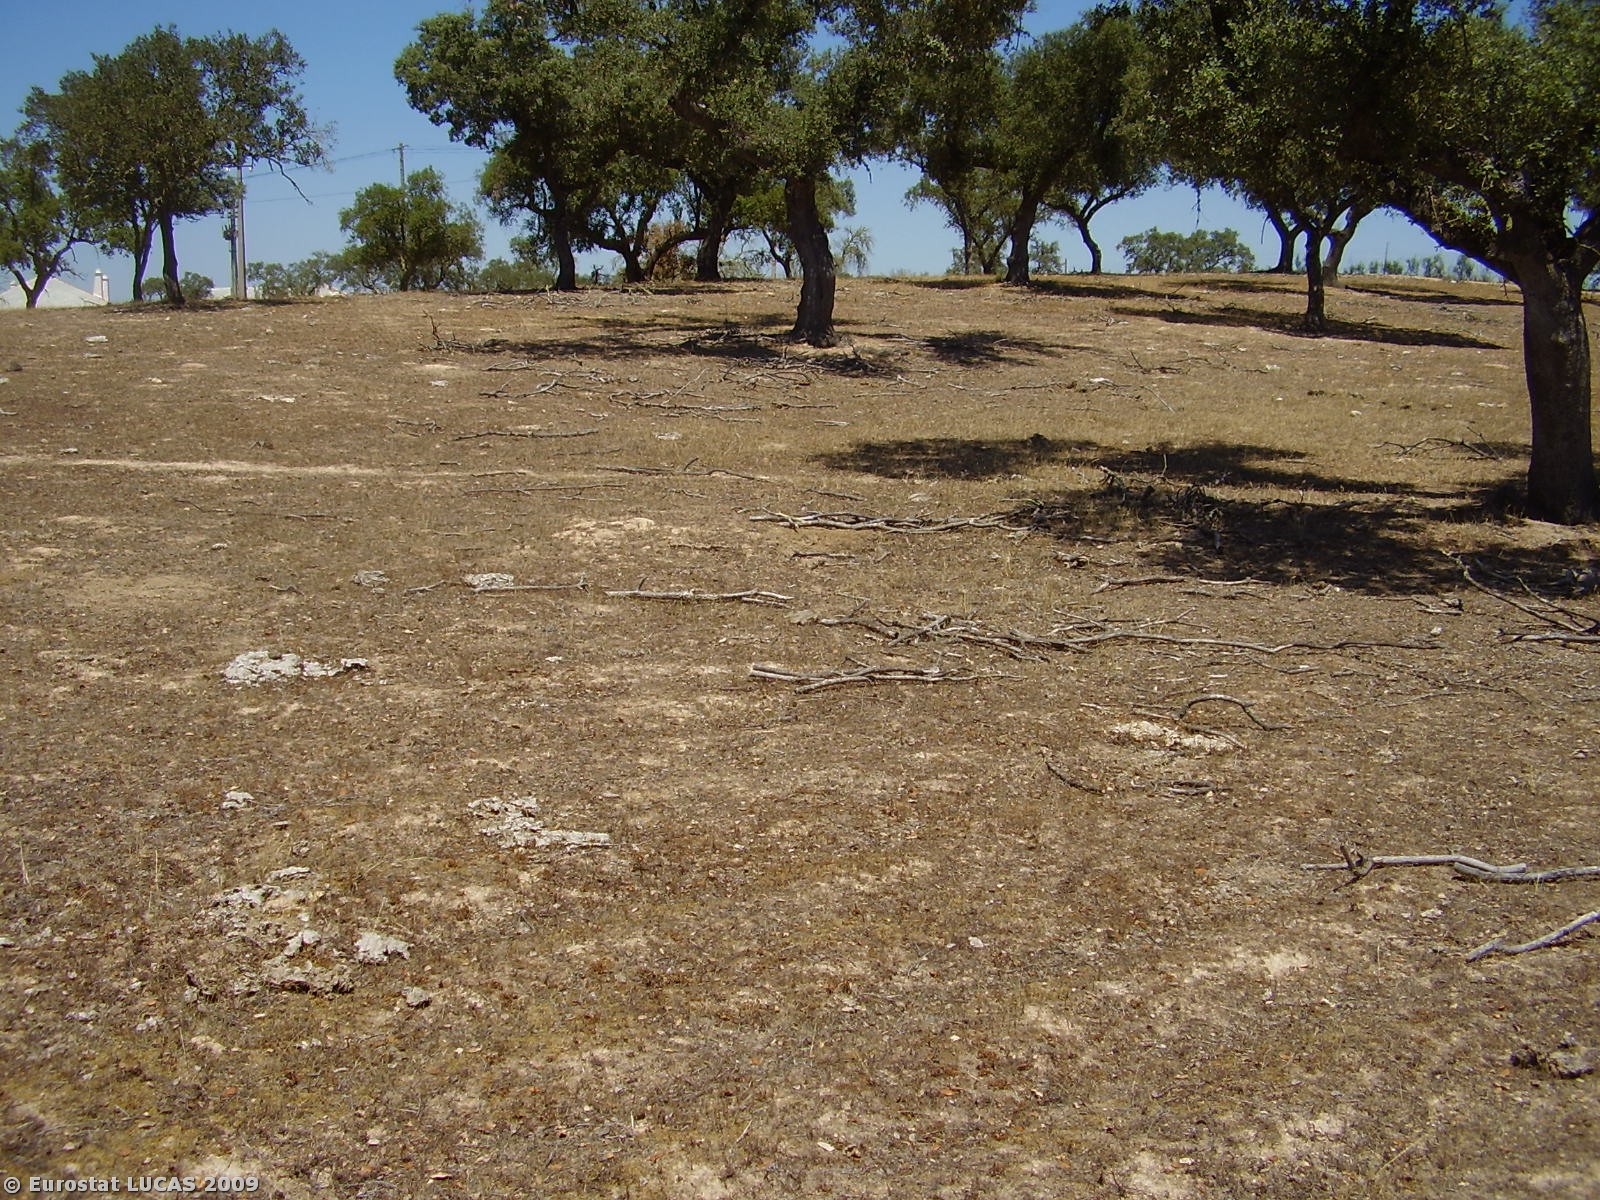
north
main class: Woodland
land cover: Broadleaved woodland
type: broadleaved evergreen forest
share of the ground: 10 - 25 %
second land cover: Grassland with sparse tree/shrub cover
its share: 50 - 75 %
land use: Forestry
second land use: Fallow land
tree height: > 5 m
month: July
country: PT
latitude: 38.8477
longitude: -7.8920
